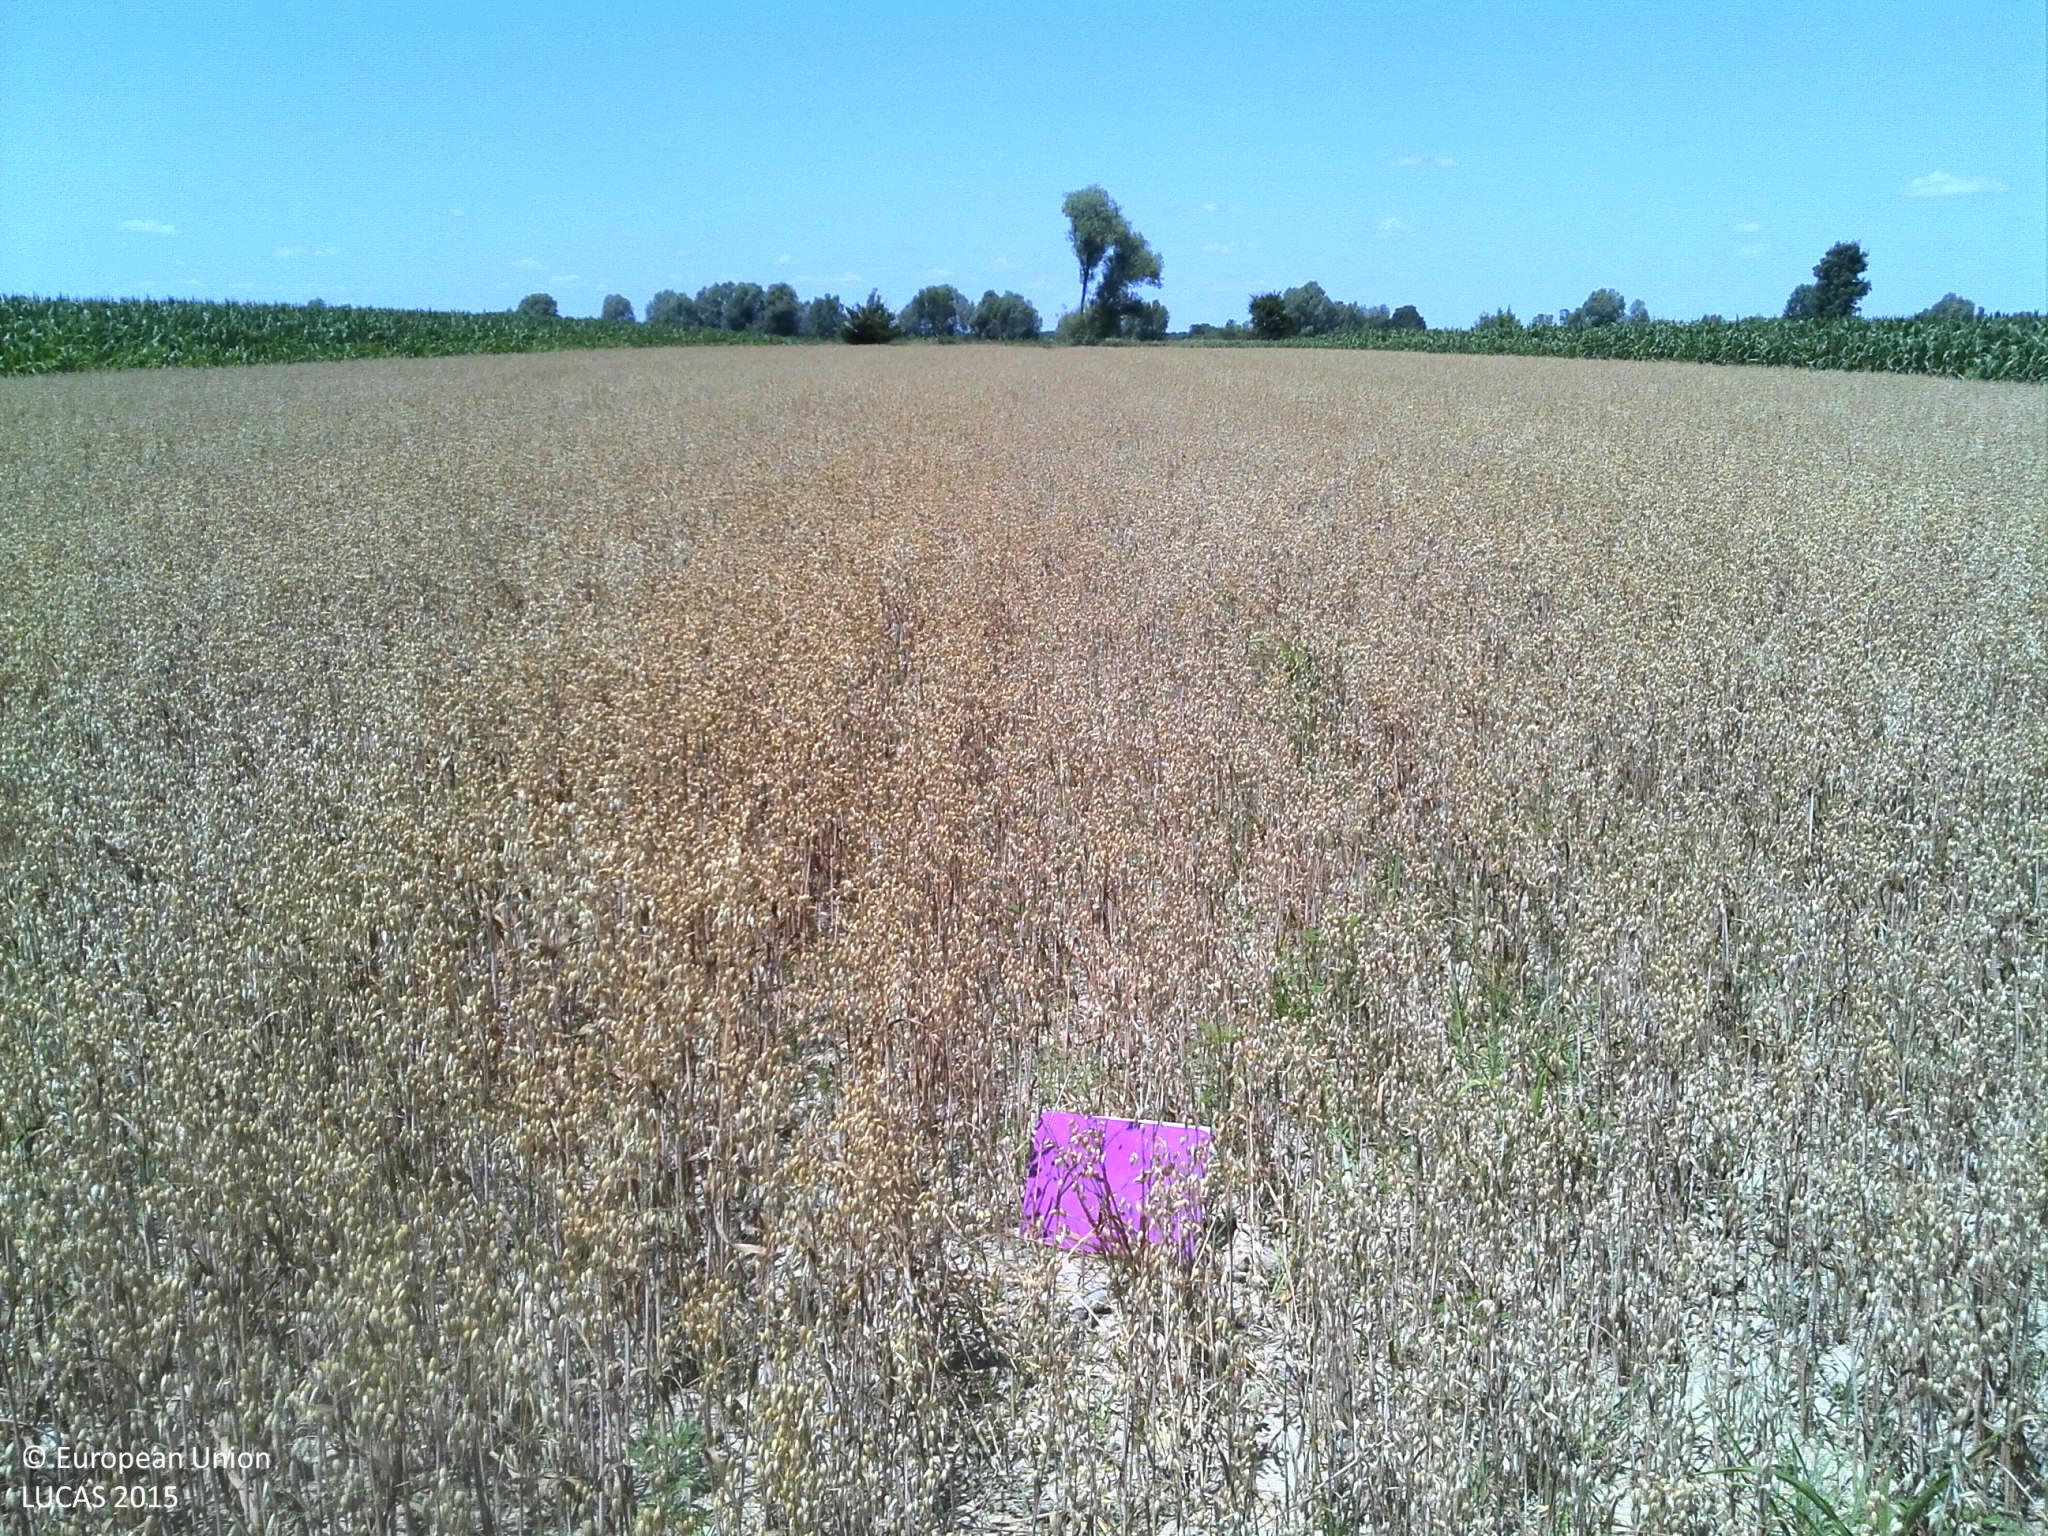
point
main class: Cropland
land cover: Oats
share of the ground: > 75 %
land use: Agriculture (excluding fallow land and kitchen gardens)
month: July
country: HR
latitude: 45.8023
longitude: 16.9098
